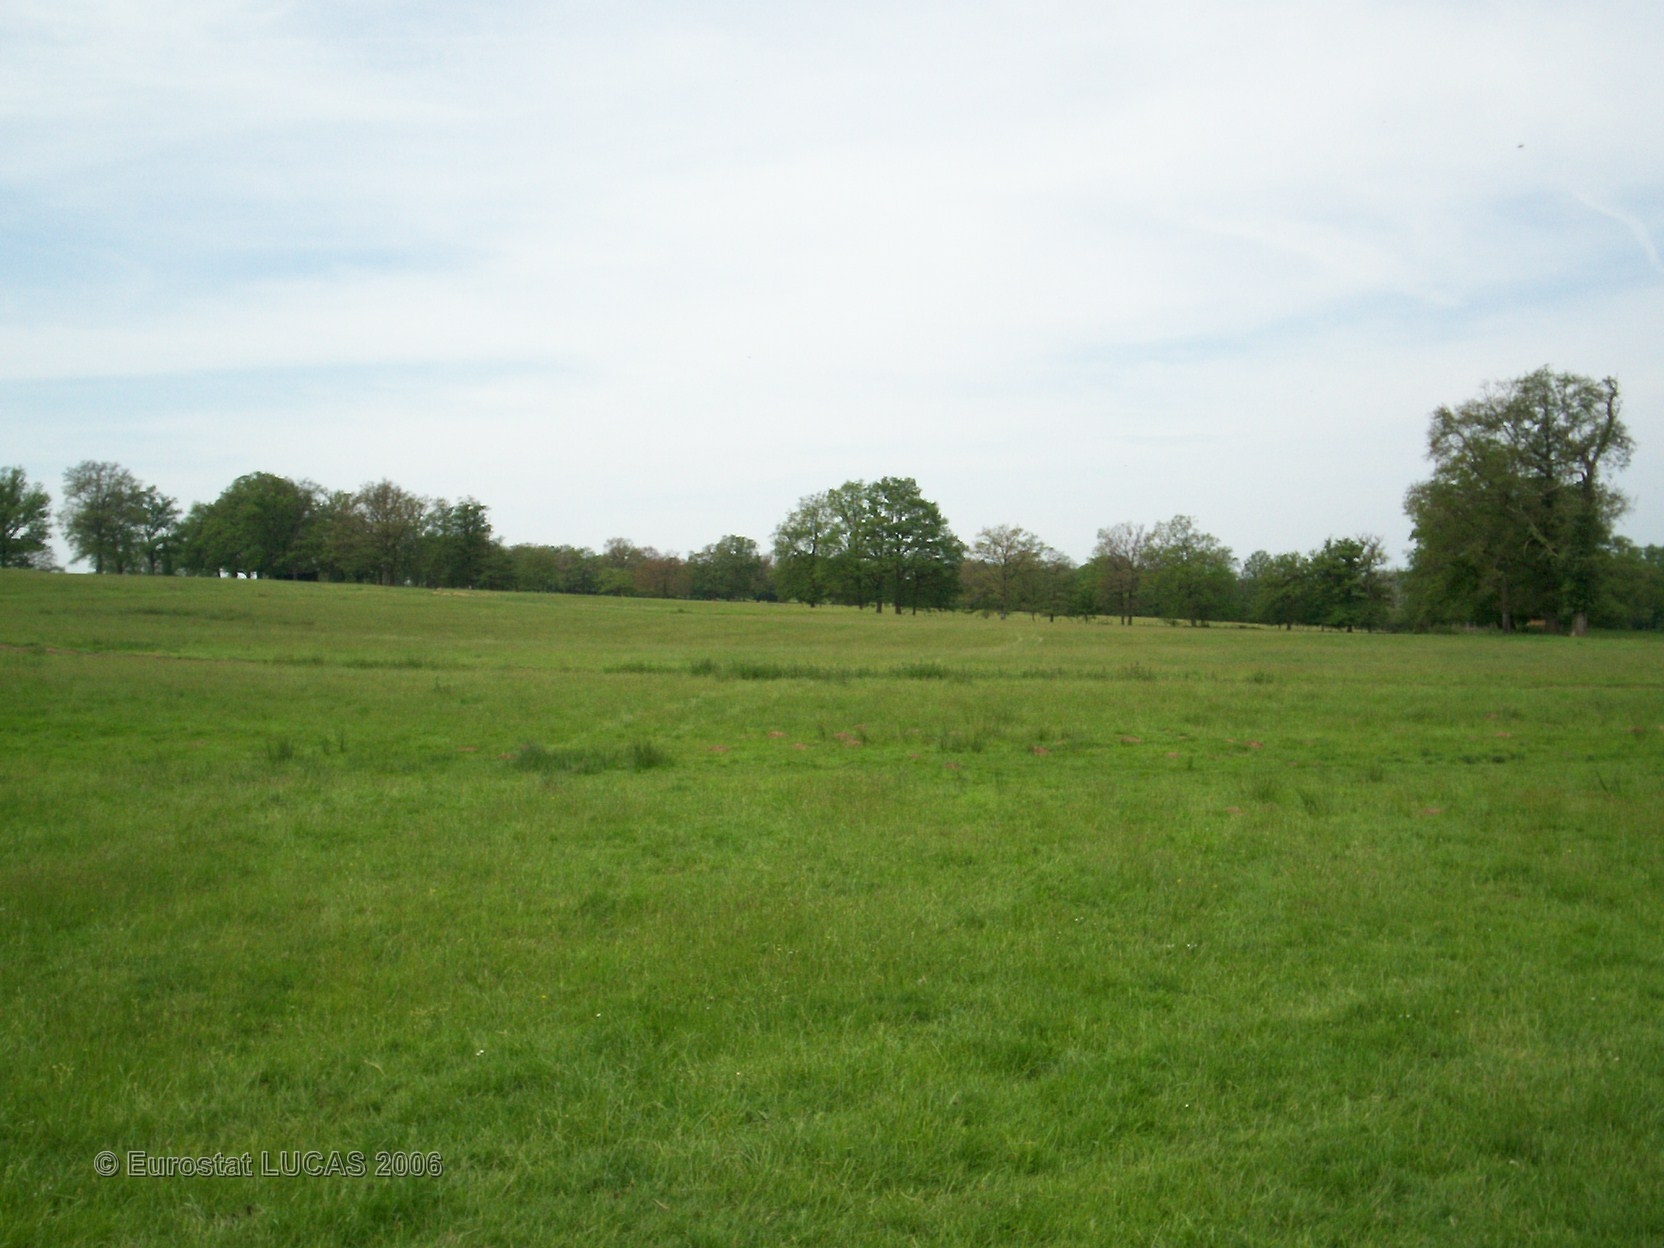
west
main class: Grassland
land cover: Grassland without tree/shrub cover
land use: Agriculture (excluding fallow land and kitchen gardens)
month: May
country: FR
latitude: 46.1622
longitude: 1.1176
